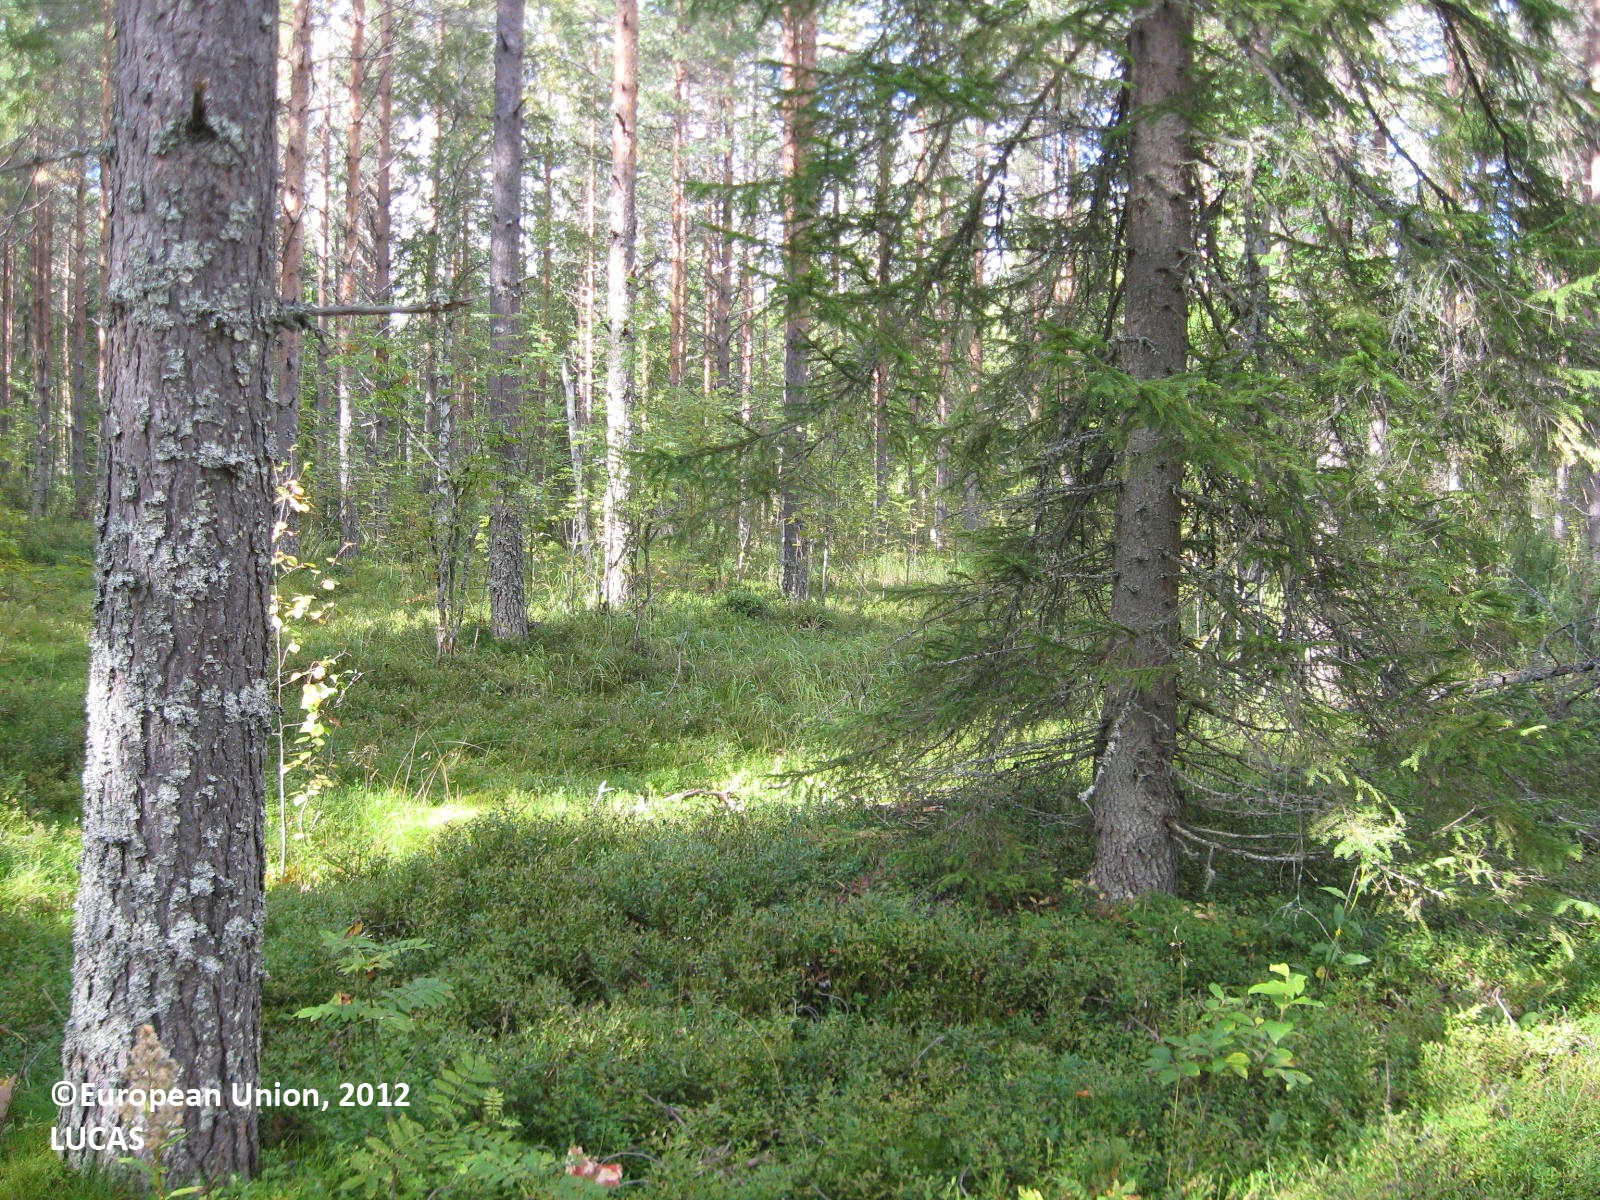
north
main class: Woodland
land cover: Pine dominated coniferous woodland
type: boreal forest
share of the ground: > 75 %
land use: Forestry
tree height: > 5 m
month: August
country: FI
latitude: 63.6163
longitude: 29.3613
